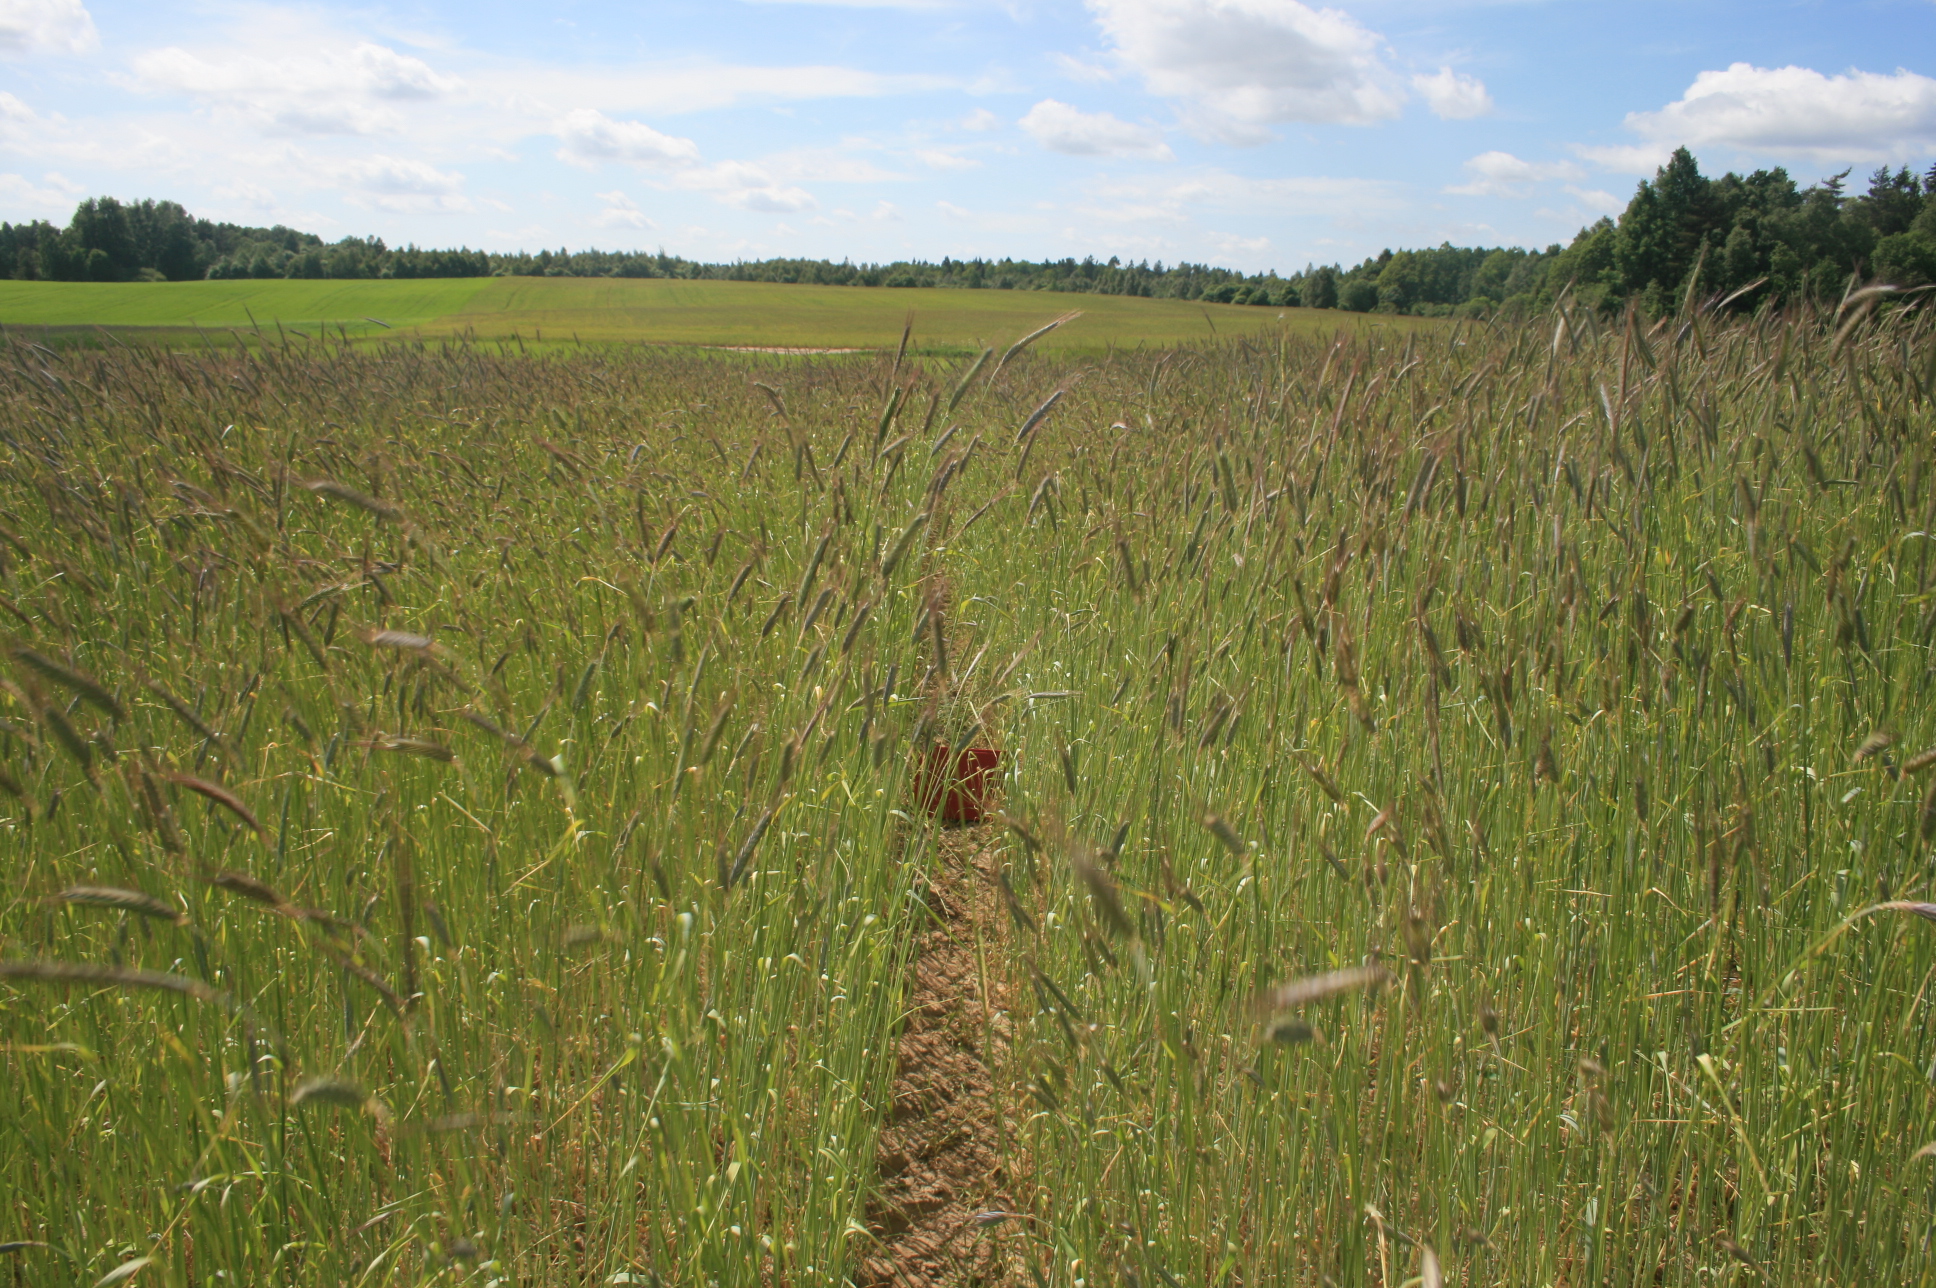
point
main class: Cropland
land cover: Rye
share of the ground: > 75 %
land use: Agriculture (excluding fallow land and kitchen gardens)
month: June
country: LT
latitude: 55.7561
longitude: 22.3106
